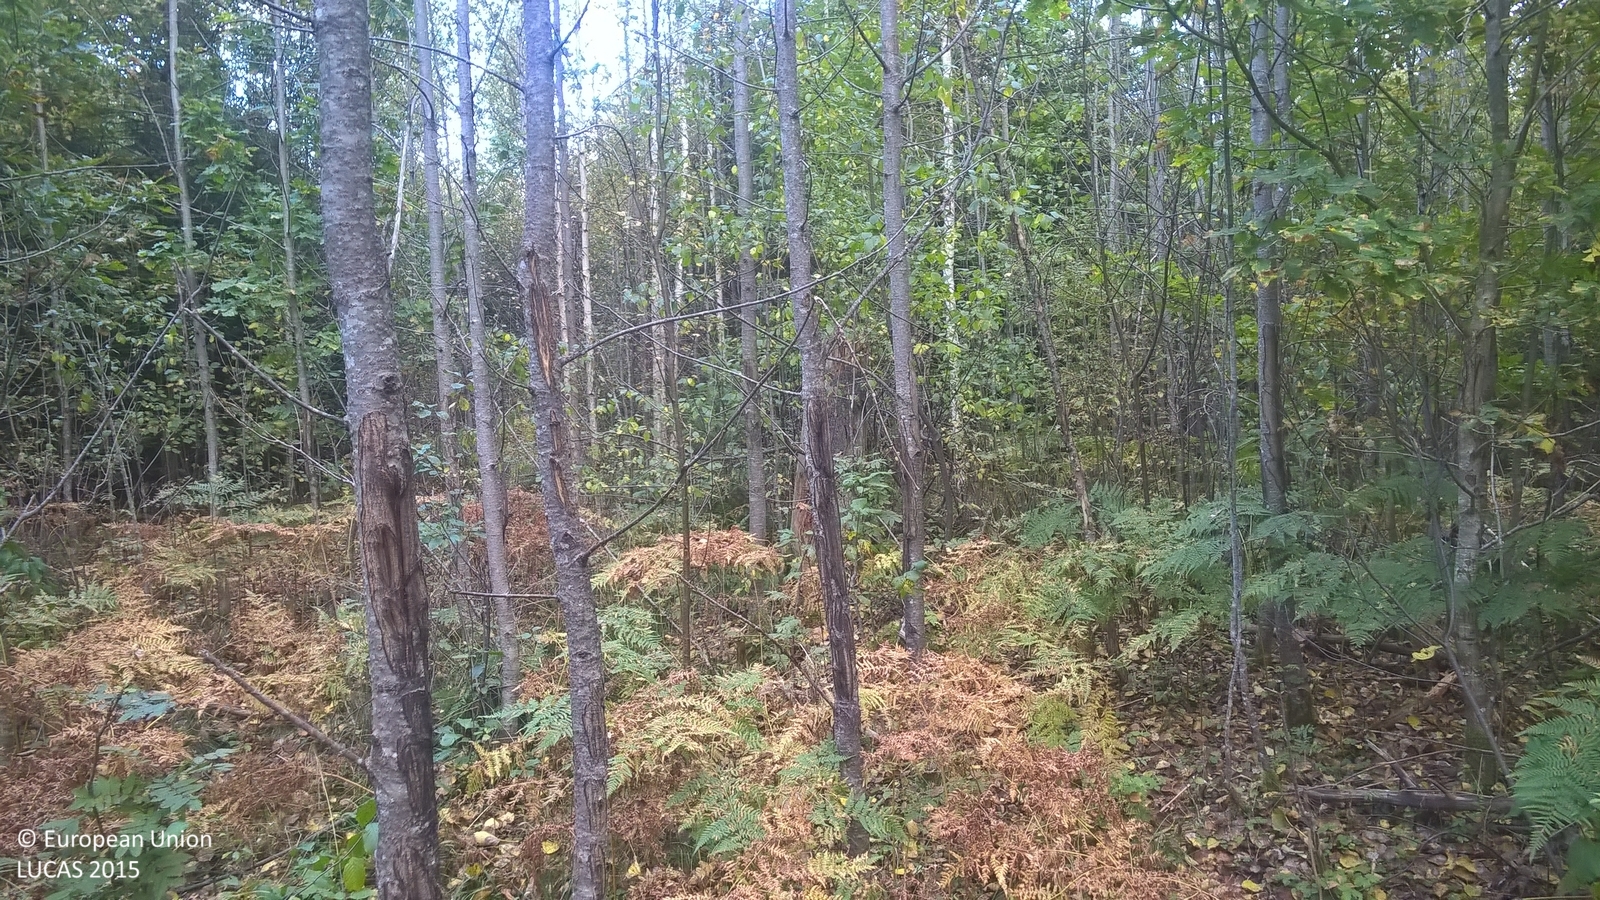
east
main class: Woodland
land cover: Spruce dominated mixed woodland
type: hemiboreal forest and nemoral coniferous forest and mixed broadleaved-coniferous forest
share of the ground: > 75 %
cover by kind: broadleaved forest trees 45 %, coniferous forest trees 30 %, lichens and mosses 25 %
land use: Forestry
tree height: > 5 m
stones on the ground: < 10 %
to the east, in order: Spruce dominated mixed woodland; Broadleaved woodland
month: September
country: LV
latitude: 57.6473
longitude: 25.6154
